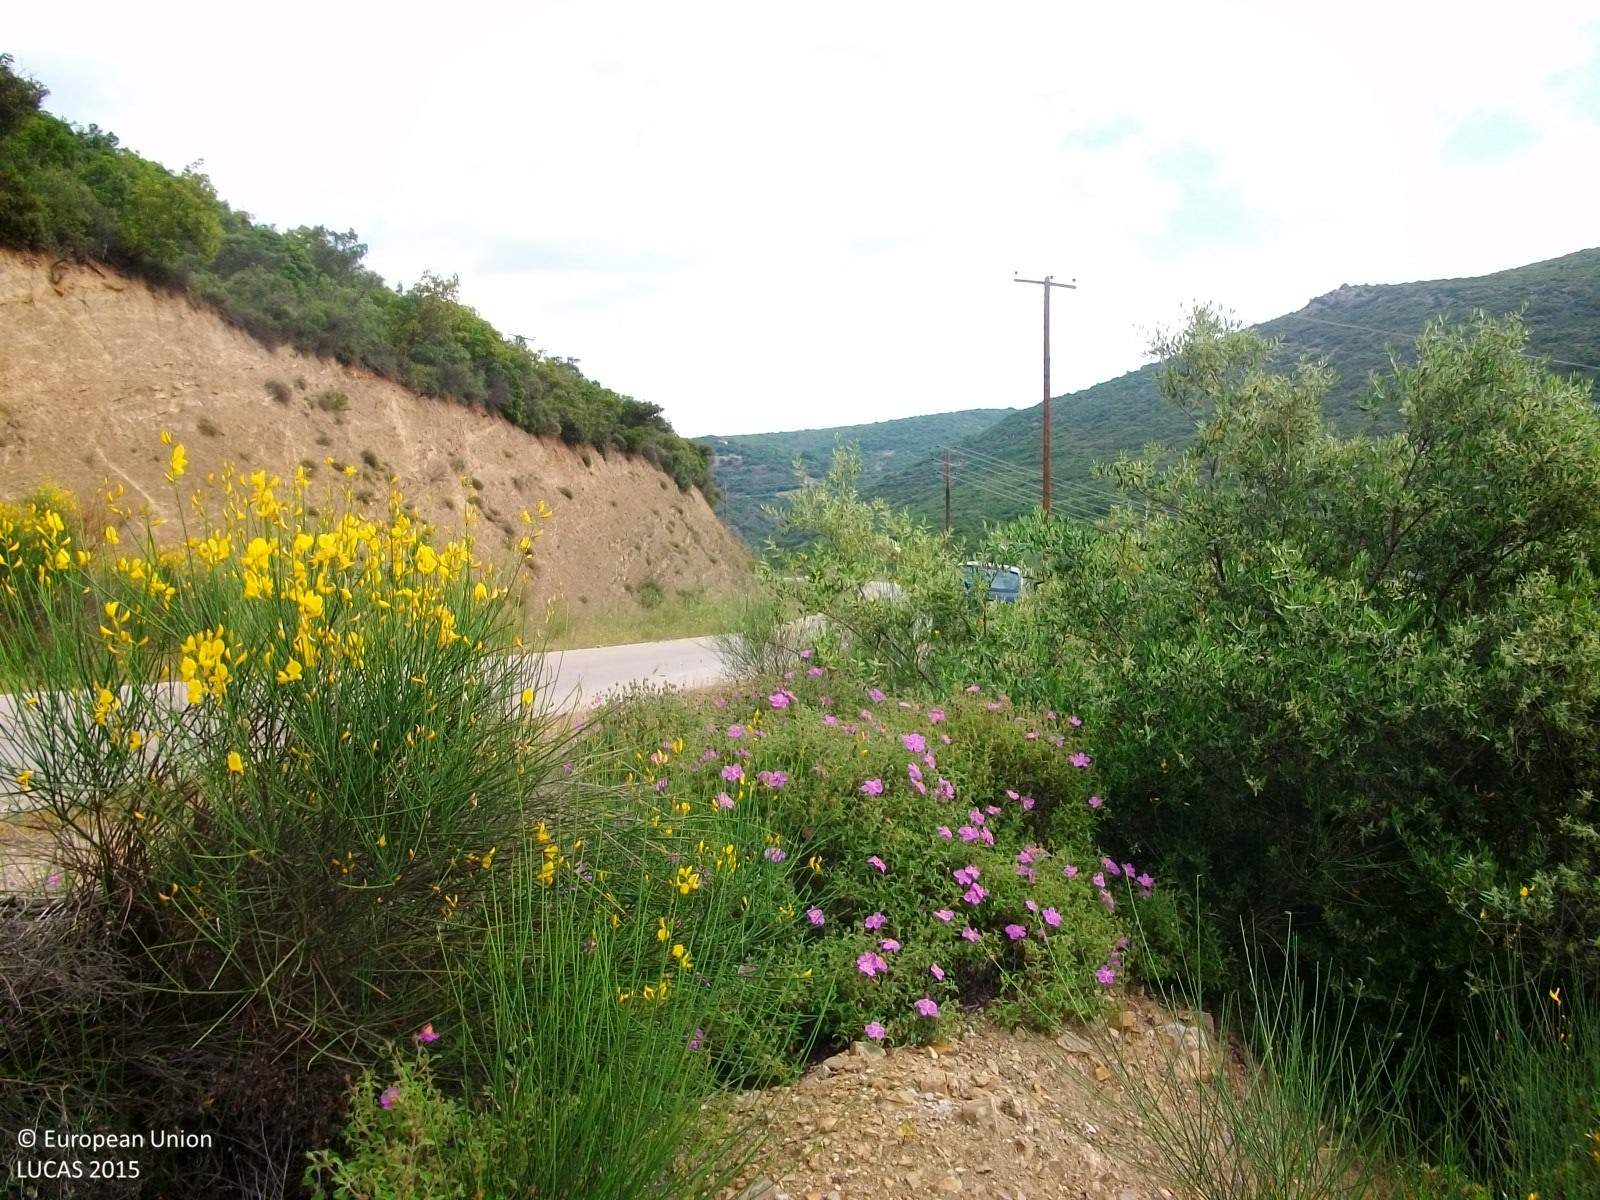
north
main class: Shrubland
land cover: Shrubland with sparse tree cover
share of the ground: > 75 %
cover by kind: shrubs 95 %, broadleaved forest trees 5 %
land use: Semi-natural and natural areas not in use
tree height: < 5 m
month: May
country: GR
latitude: 38.9402
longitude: 22.5925
